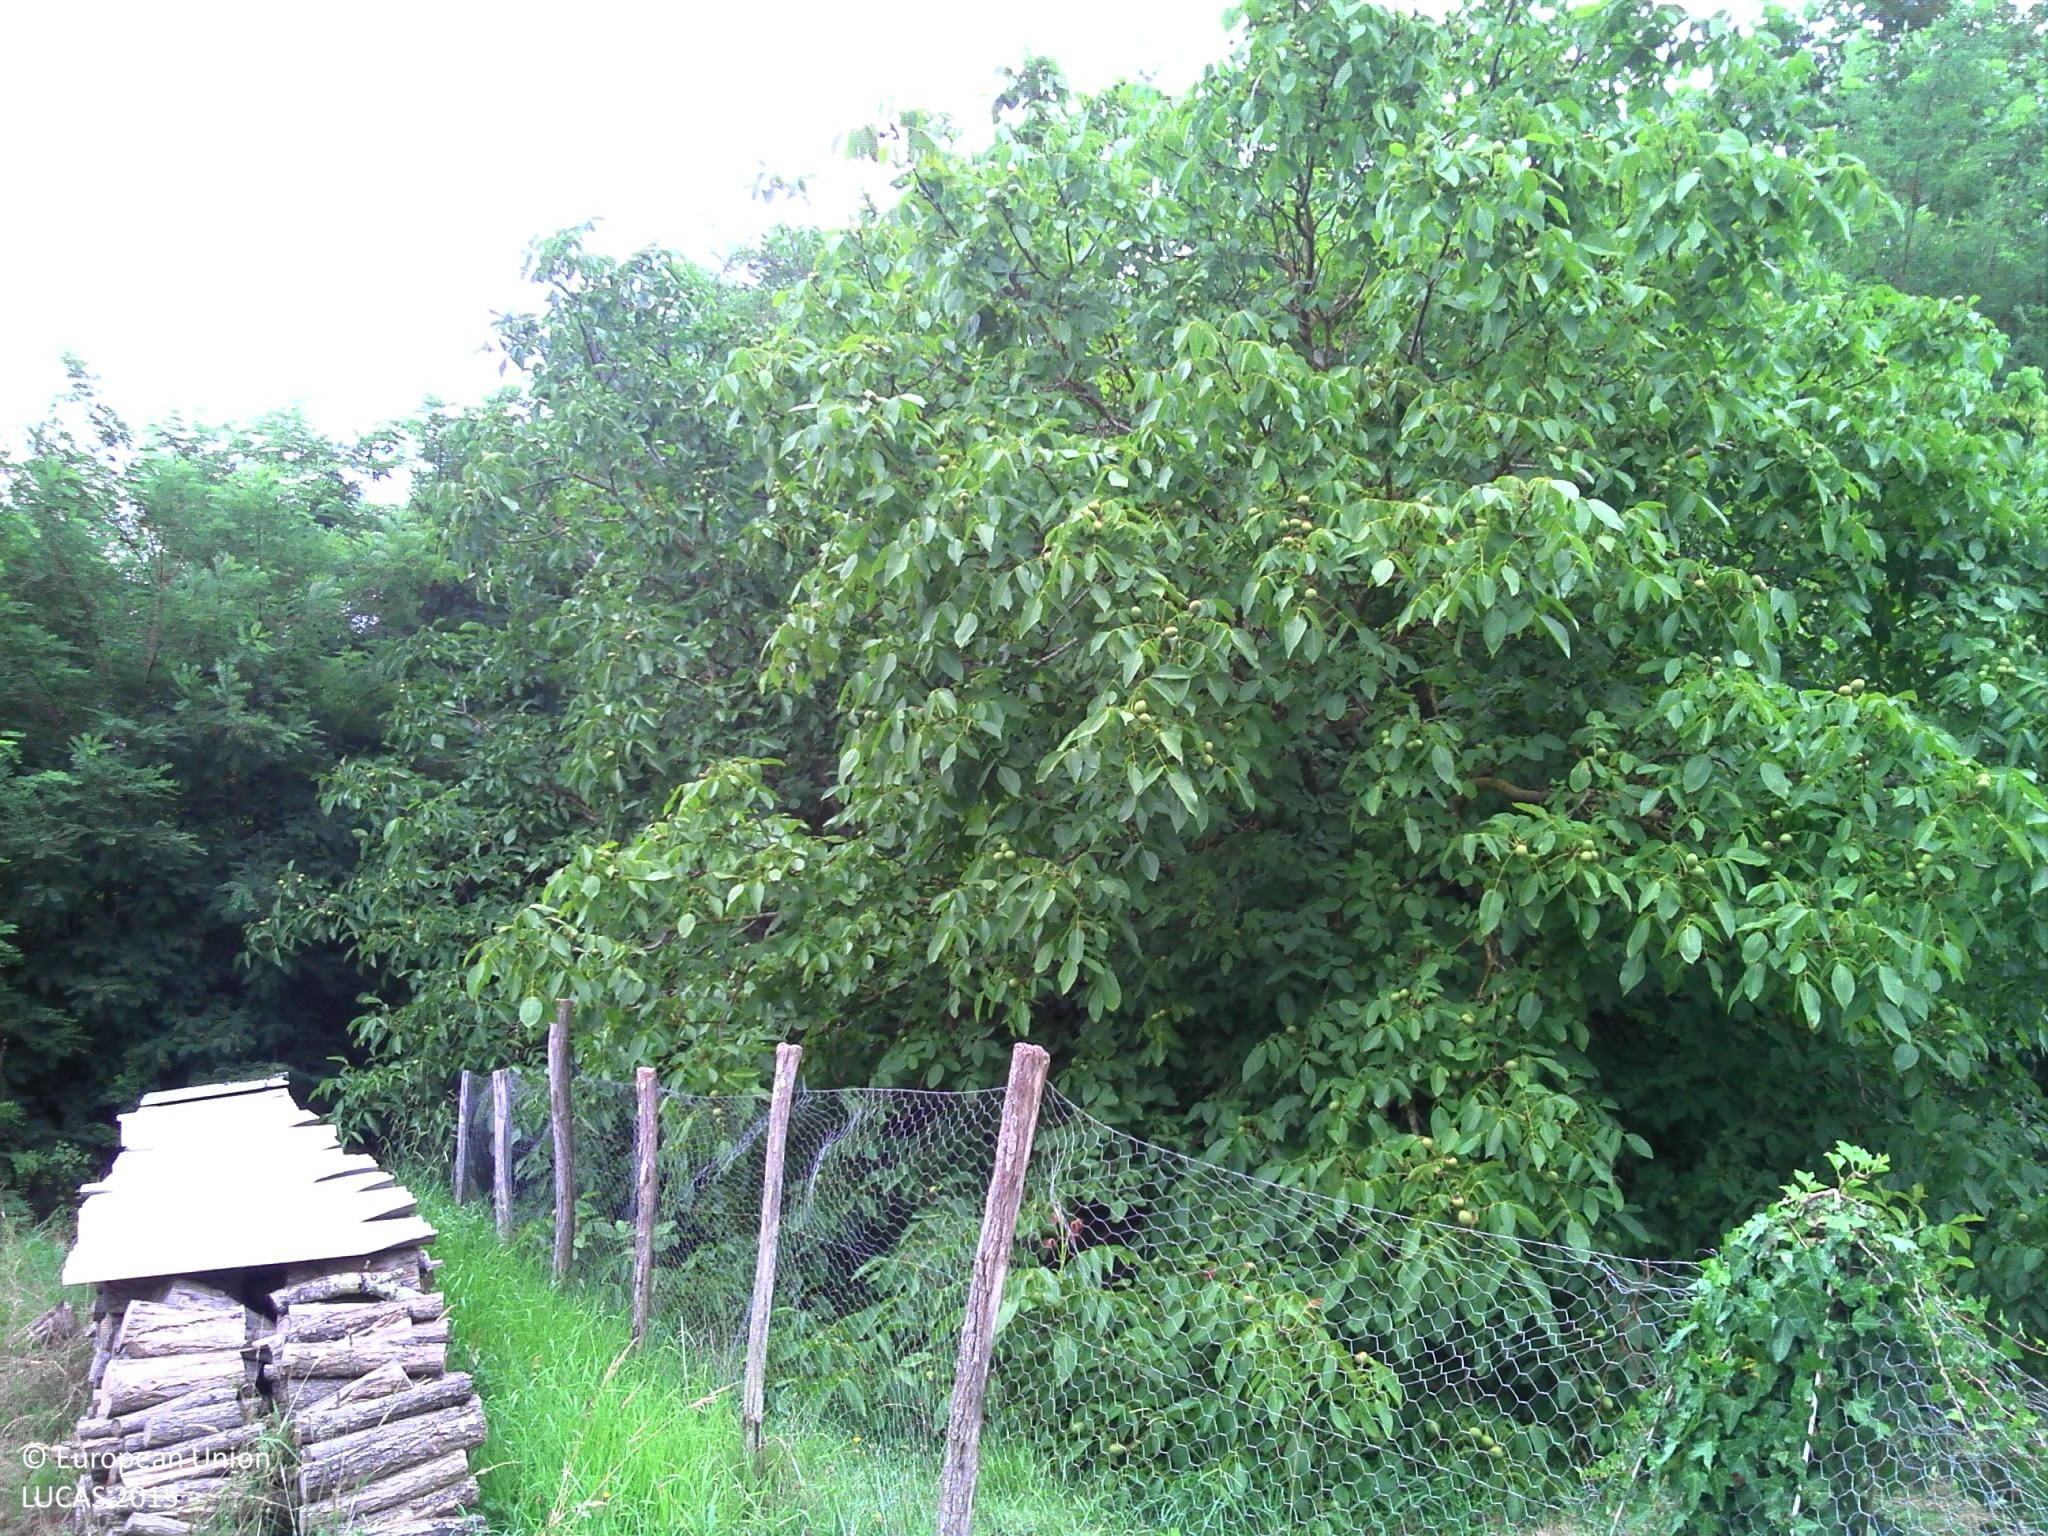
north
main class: Grassland
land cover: Grassland without tree/shrub cover
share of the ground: > 75 %
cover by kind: herbaceous plants 100 %
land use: Residential
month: July
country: FR
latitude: 43.5992
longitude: -1.1775
